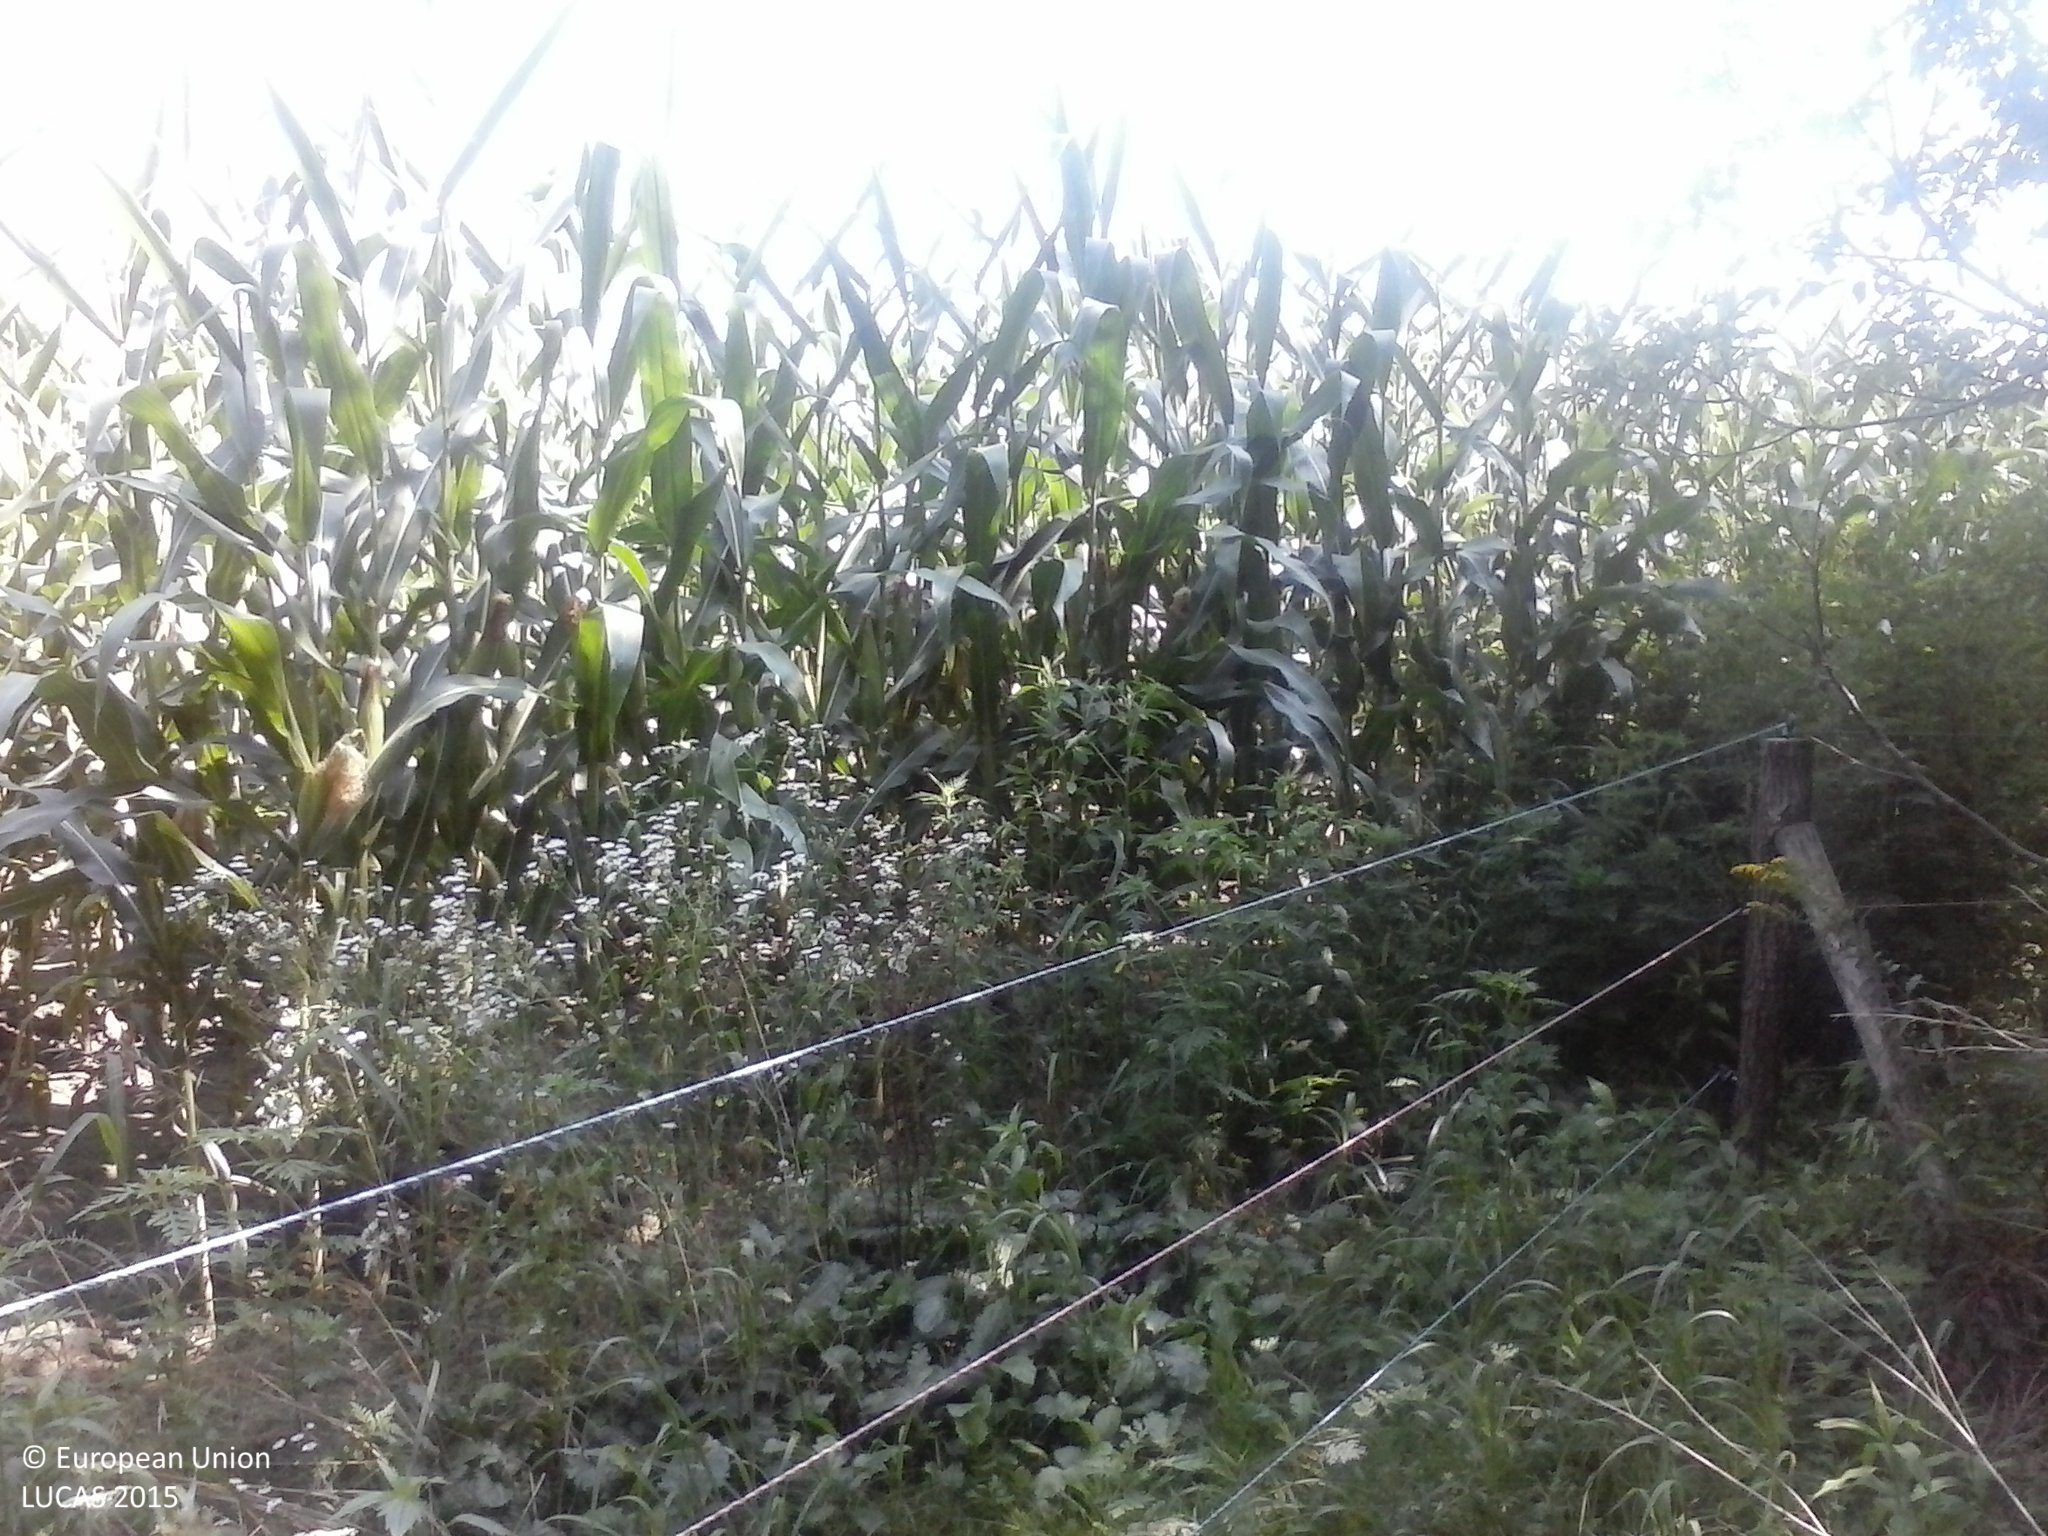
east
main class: Cropland
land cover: Maize
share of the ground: > 75 %
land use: Agriculture (excluding fallow land and kitchen gardens)
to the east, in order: Maize; Fences; Broadleaved woodland; Grass margins; Paved roads, cycling and walking lanes; Grass margins; Abandoned hedges; Grass margins; Fences; Spontaneously vegetated surfaces
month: August
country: HU
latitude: 45.8993
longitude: 17.8540
